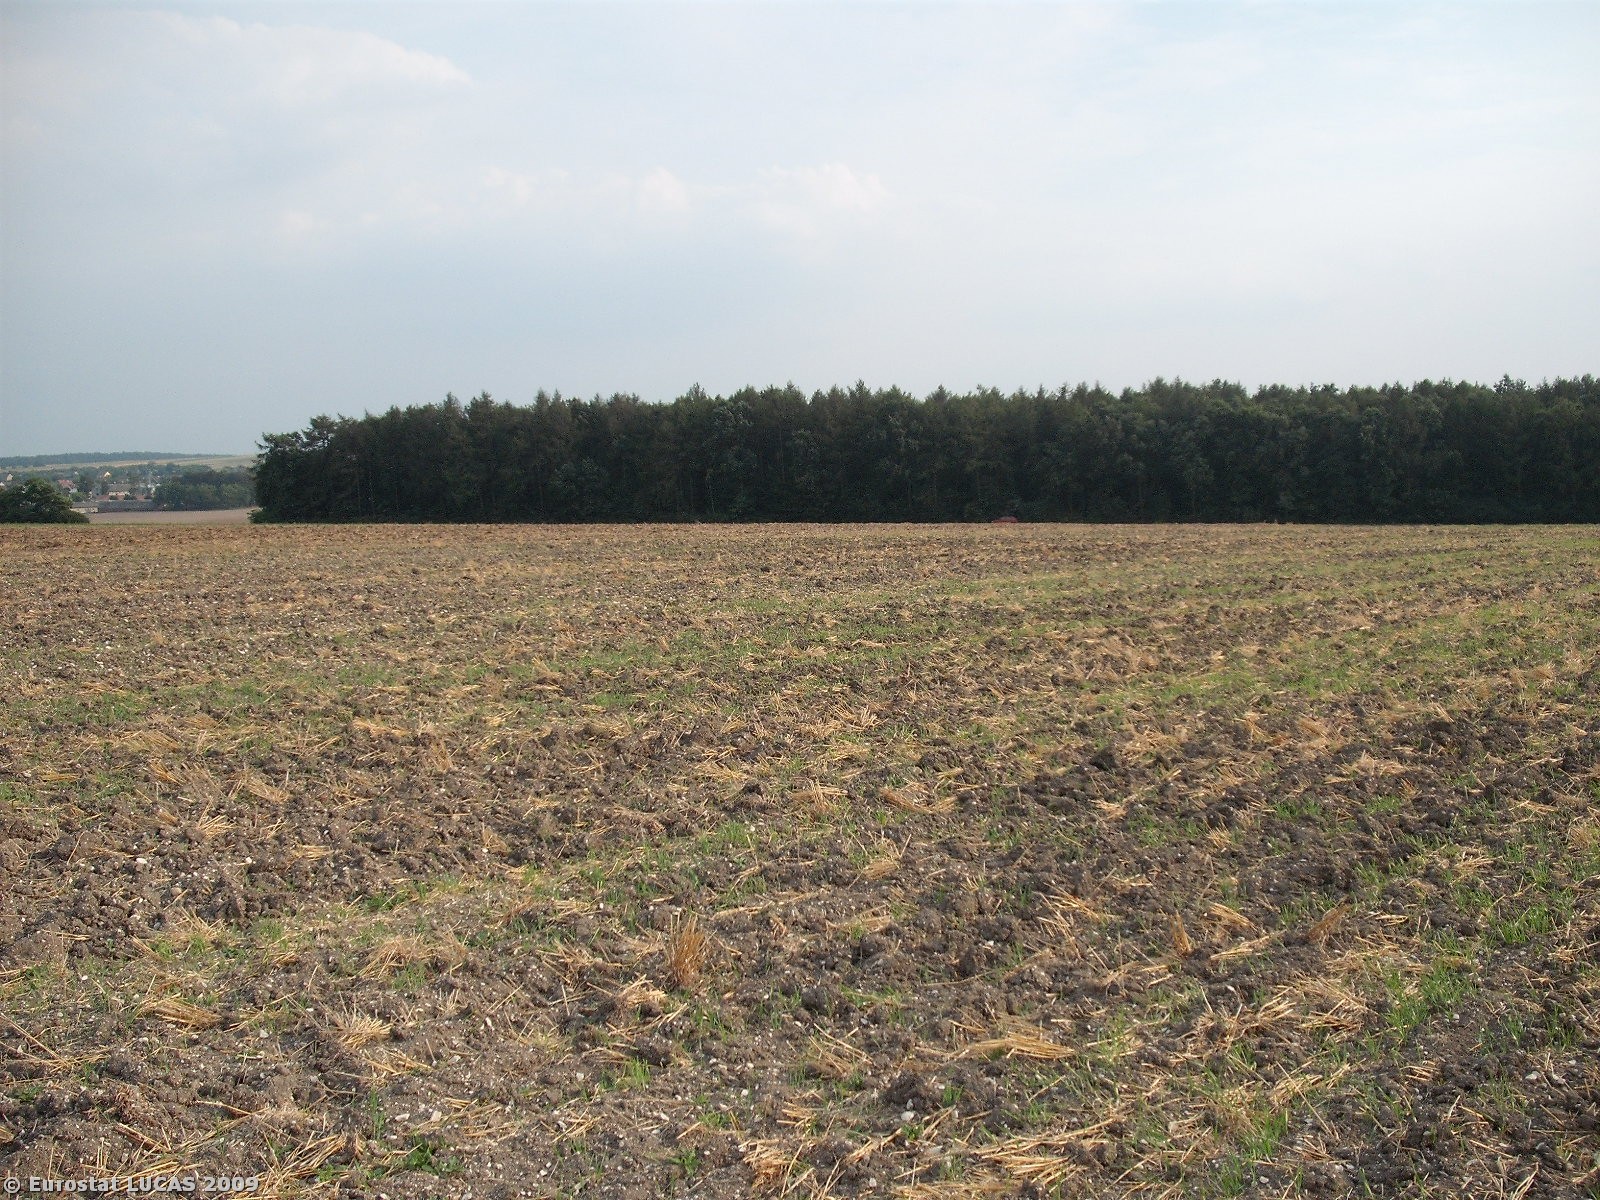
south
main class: Cropland
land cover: Barley
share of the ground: < 10 %
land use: Agriculture (excluding fallow land and kitchen gardens)
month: September
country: PL
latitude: 50.4772
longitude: 20.3086
